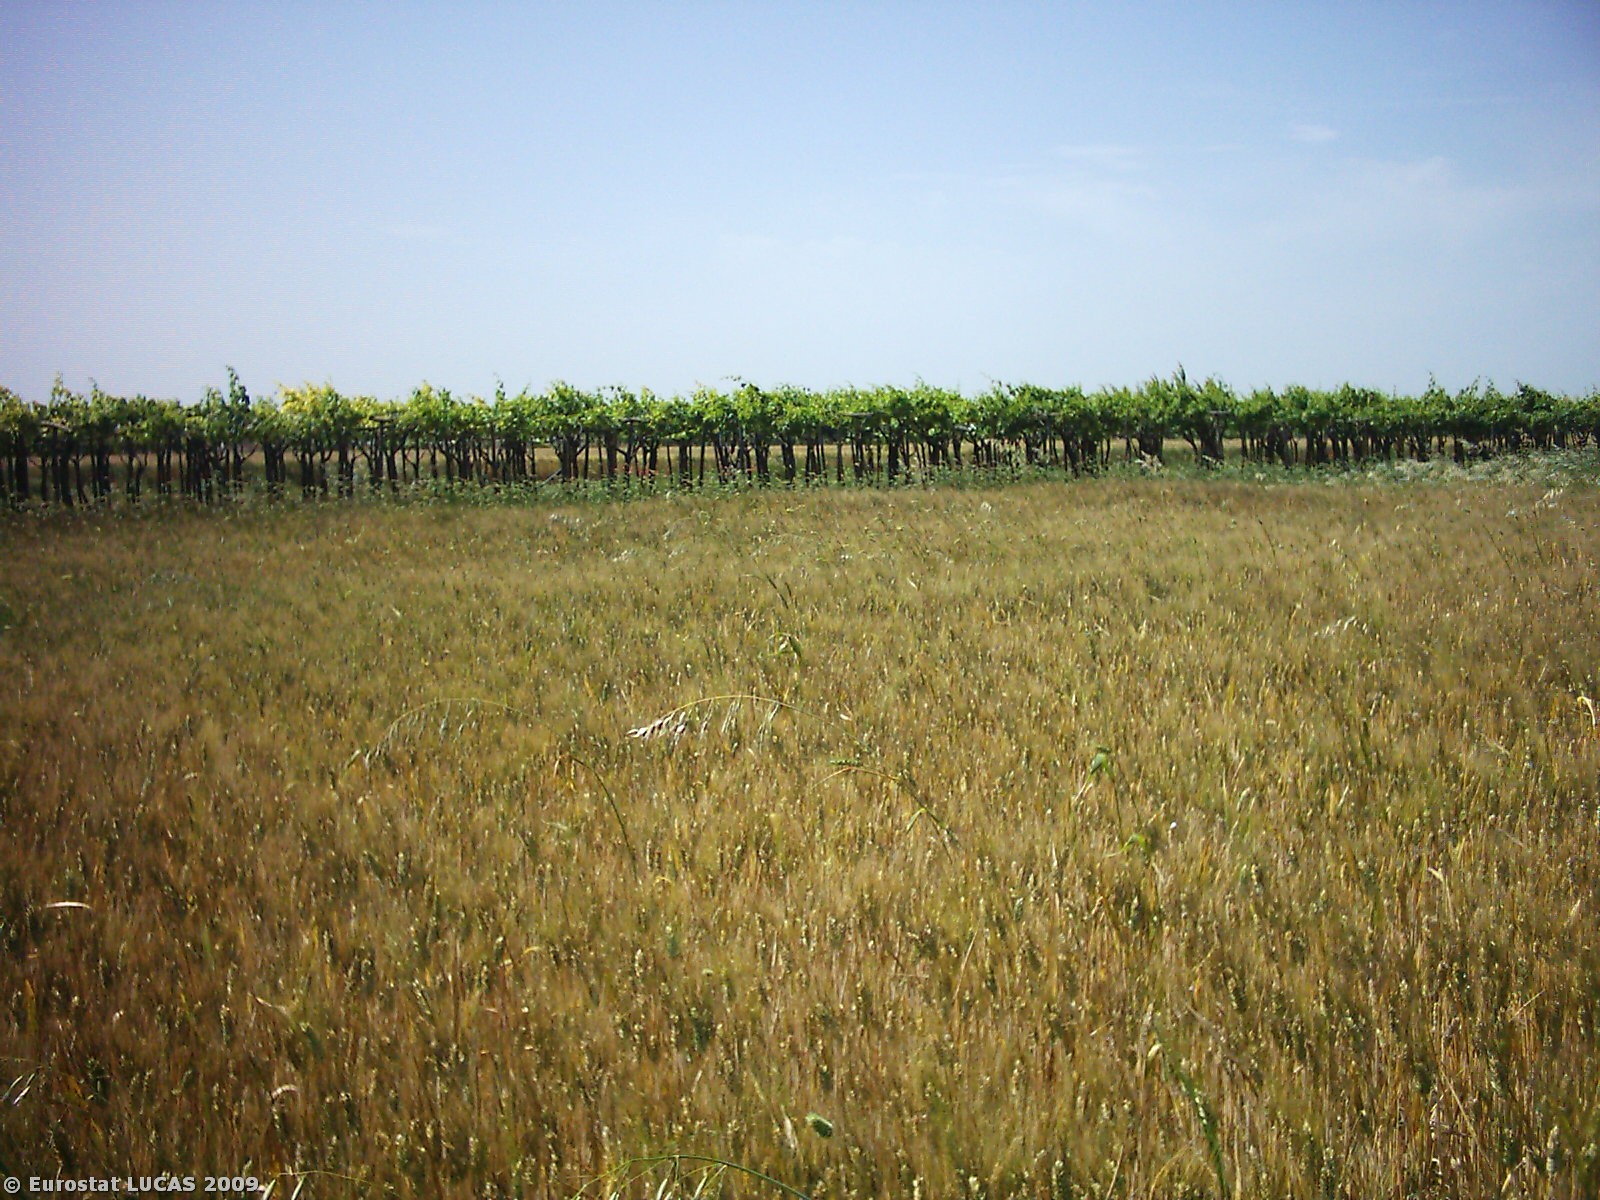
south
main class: Cropland
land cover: Durum wheat
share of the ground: > 75 %
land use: Agriculture (excluding fallow land and kitchen gardens)
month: May
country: IT
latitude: 41.3562
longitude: 15.6351
